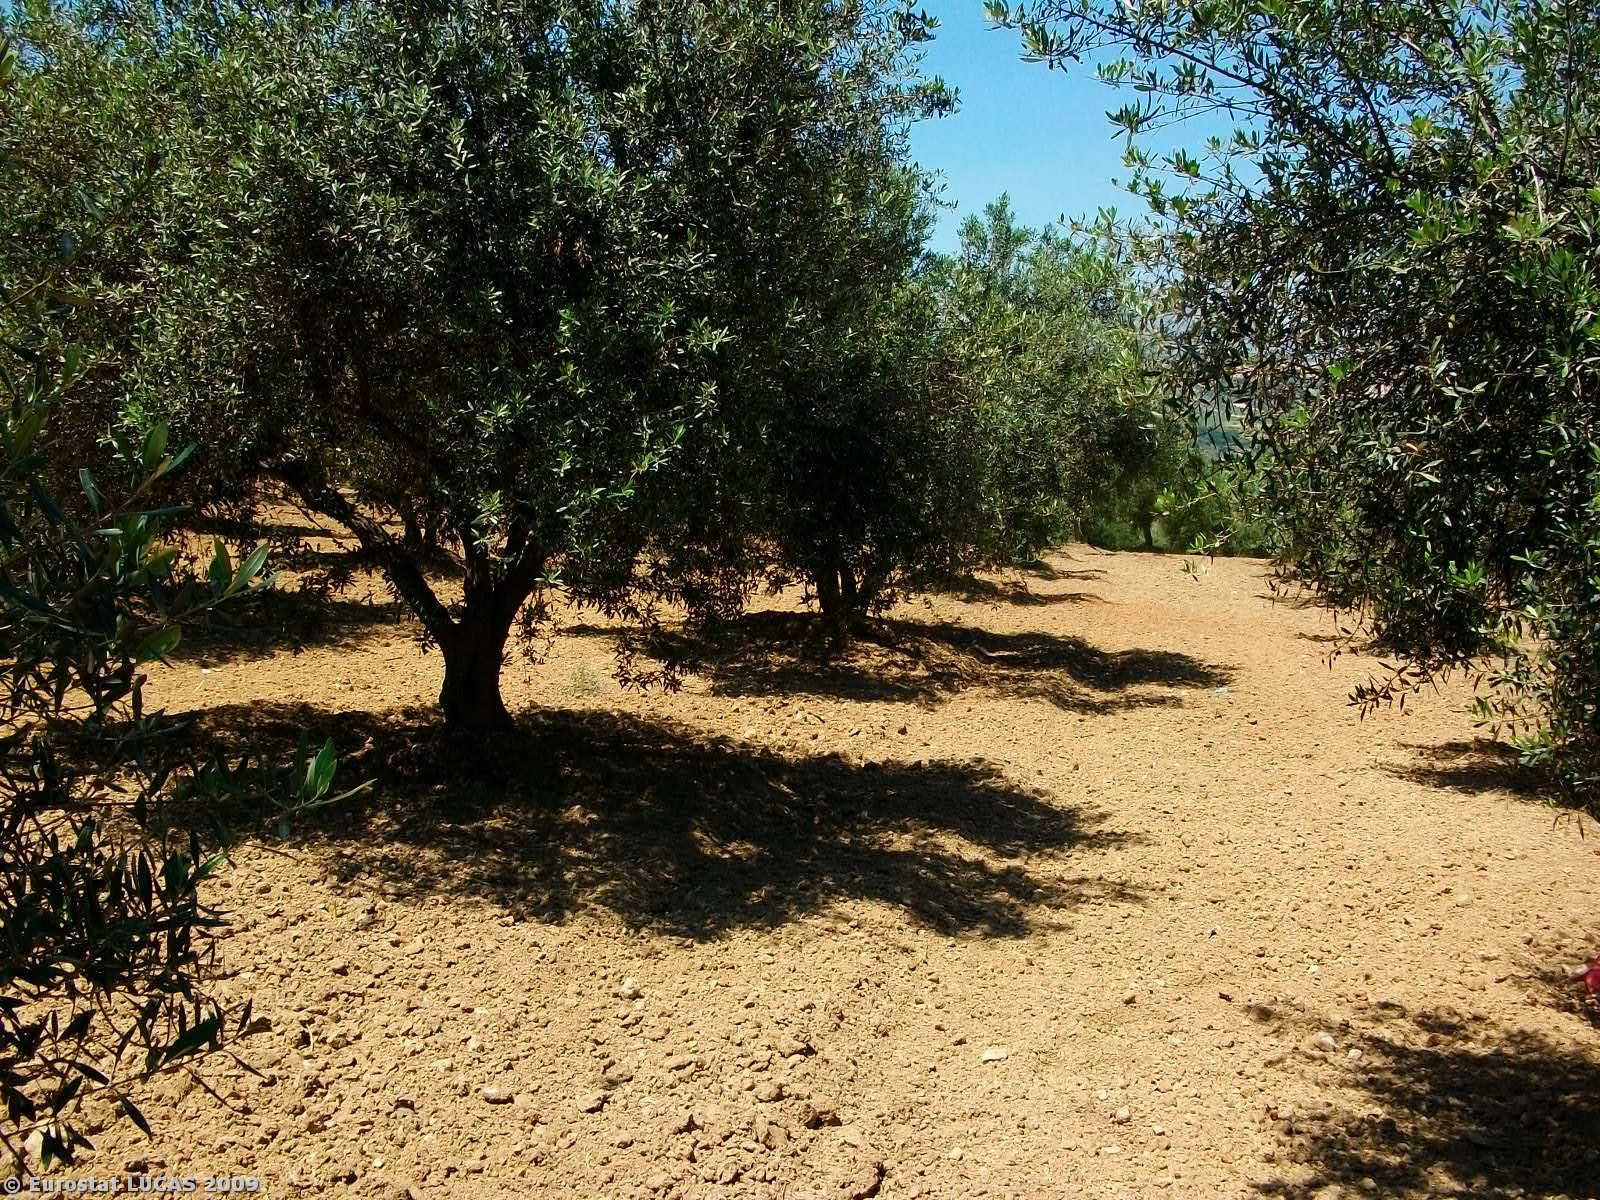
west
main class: Cropland
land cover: Olive groves
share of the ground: 50 - 75 %
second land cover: Bare land
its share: > 75 %
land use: Agriculture (excluding fallow land and kitchen gardens)
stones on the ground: < 10 %
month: May
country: GR
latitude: 35.2084
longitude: 25.0942
